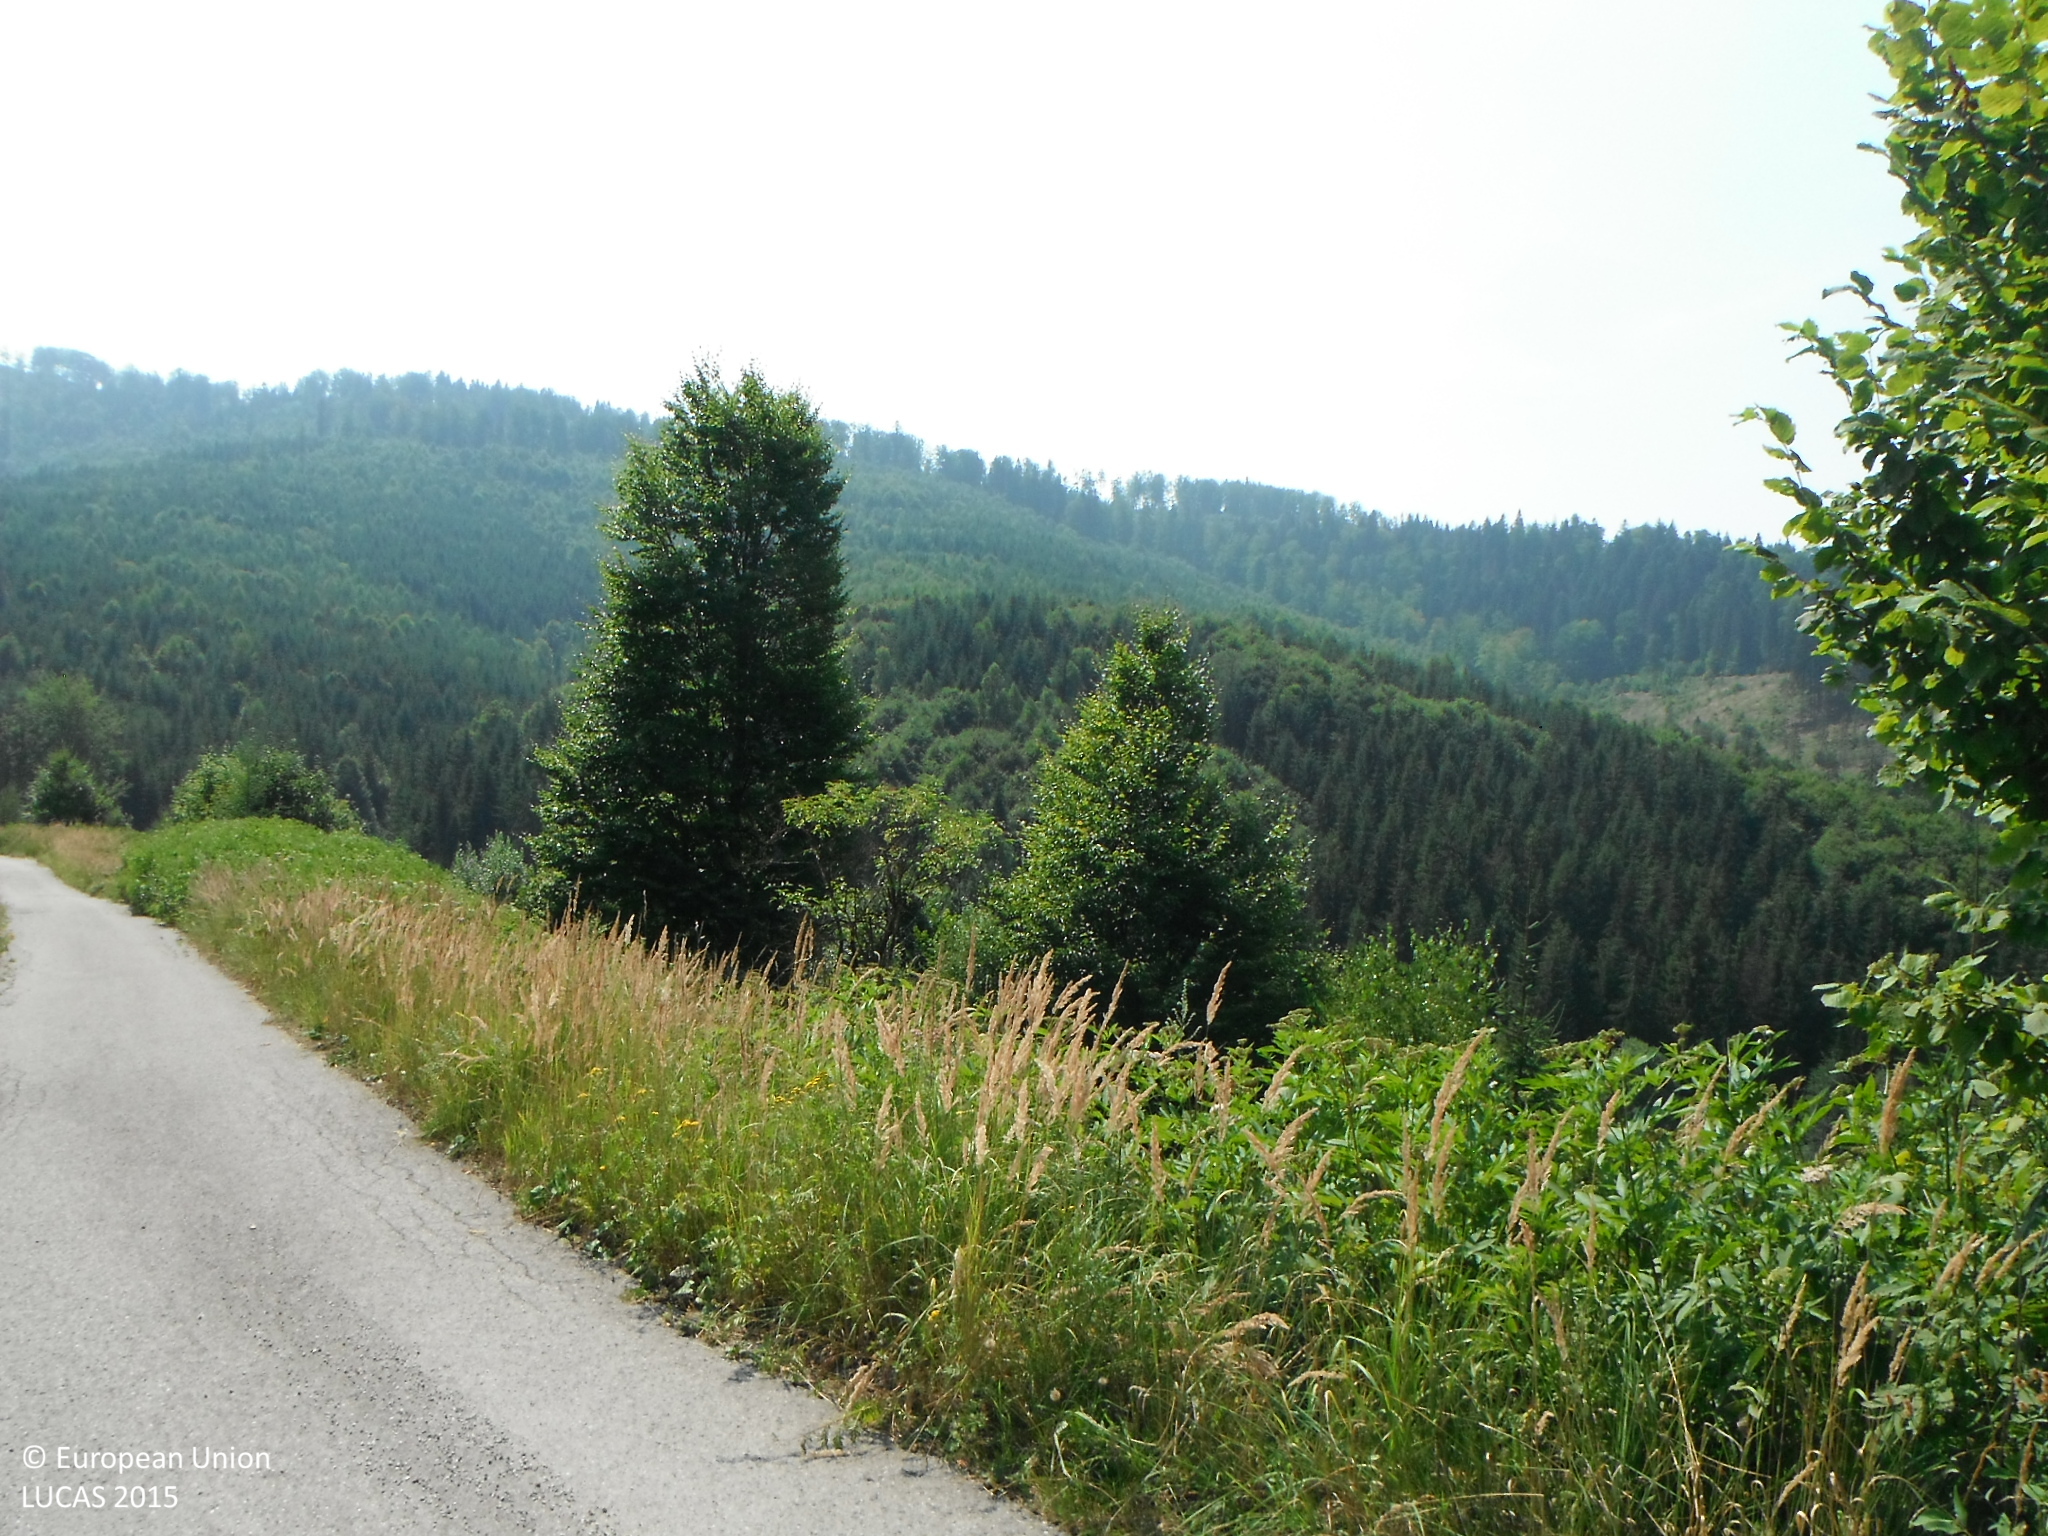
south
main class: Woodland
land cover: Spruce dominated mixed woodland
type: alpine coniferous forest
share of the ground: > 75 %
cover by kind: coniferous forest trees 70 %, broadleaved forest trees 30 %
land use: Forestry
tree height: > 5 m
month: August
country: SK
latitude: 49.4606
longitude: 18.8372
